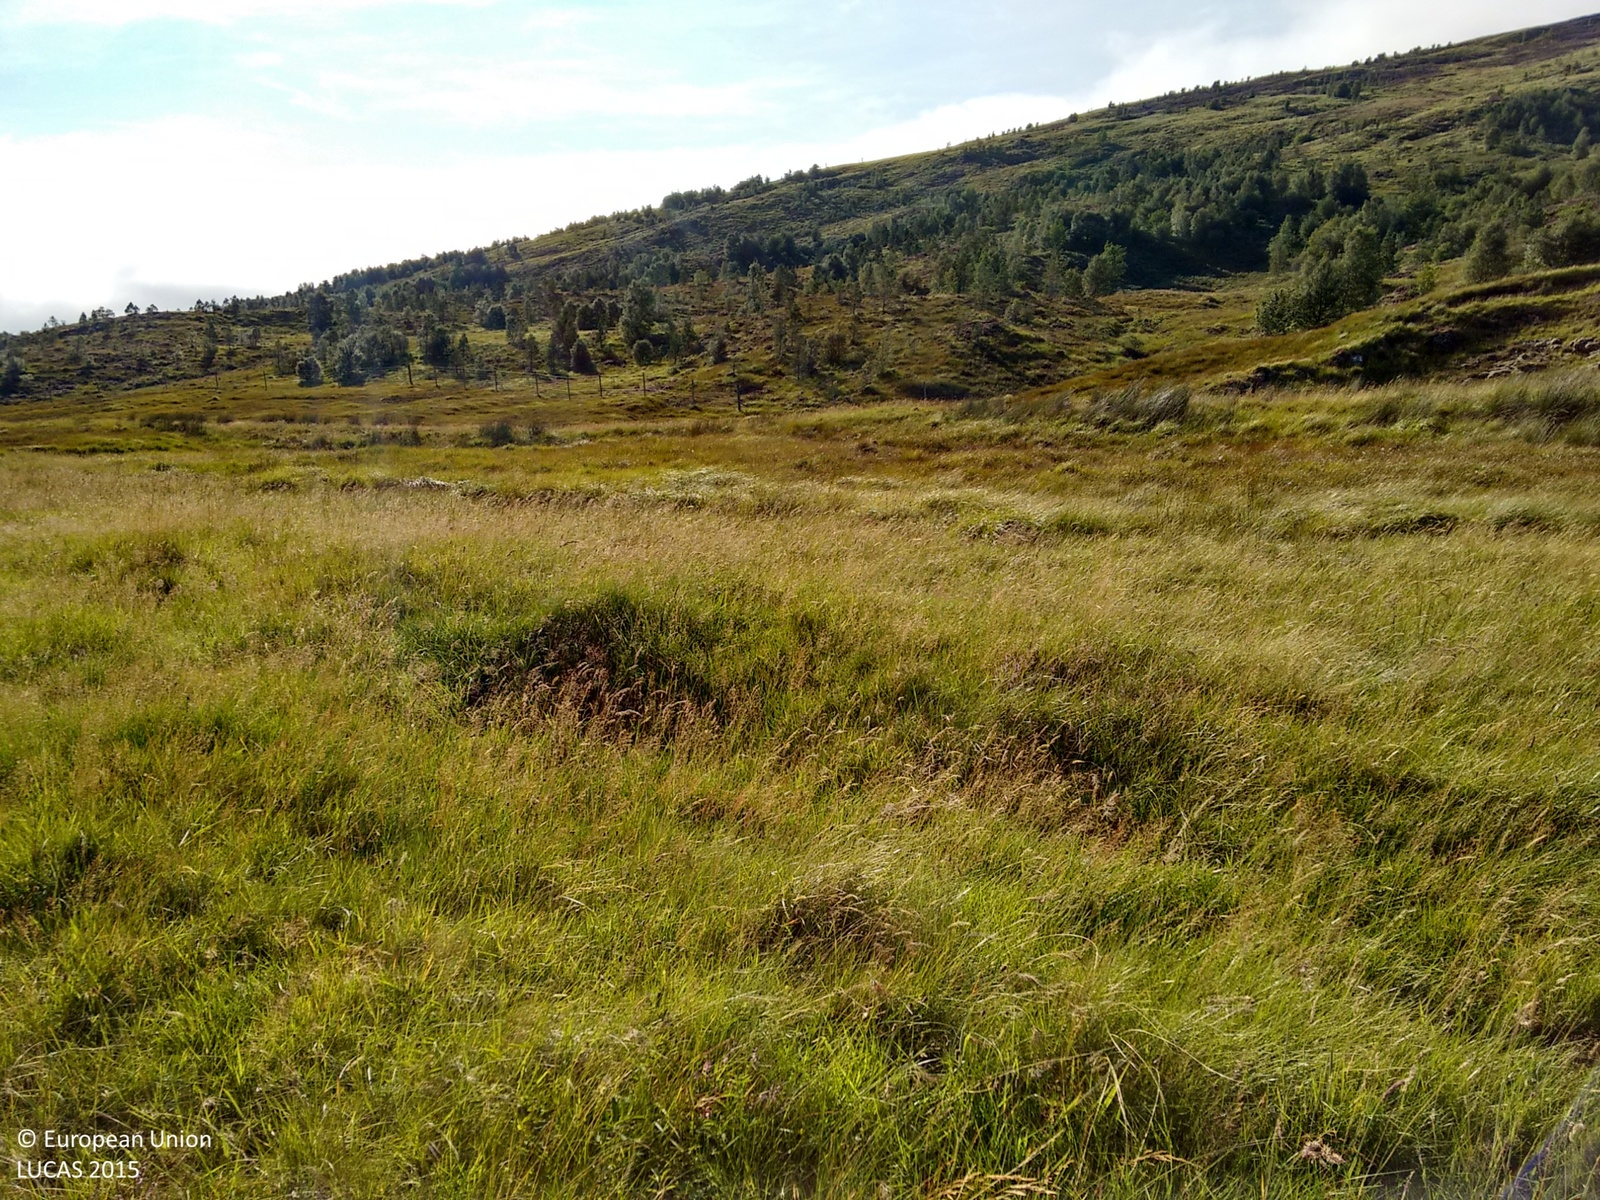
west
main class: Grassland
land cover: Grassland without tree/shrub cover
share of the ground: > 75 %
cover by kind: herbaceous plants 100 %
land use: Agriculture (excluding fallow land and kitchen gardens)
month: September
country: GB
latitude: 58.2359
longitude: -4.4778
